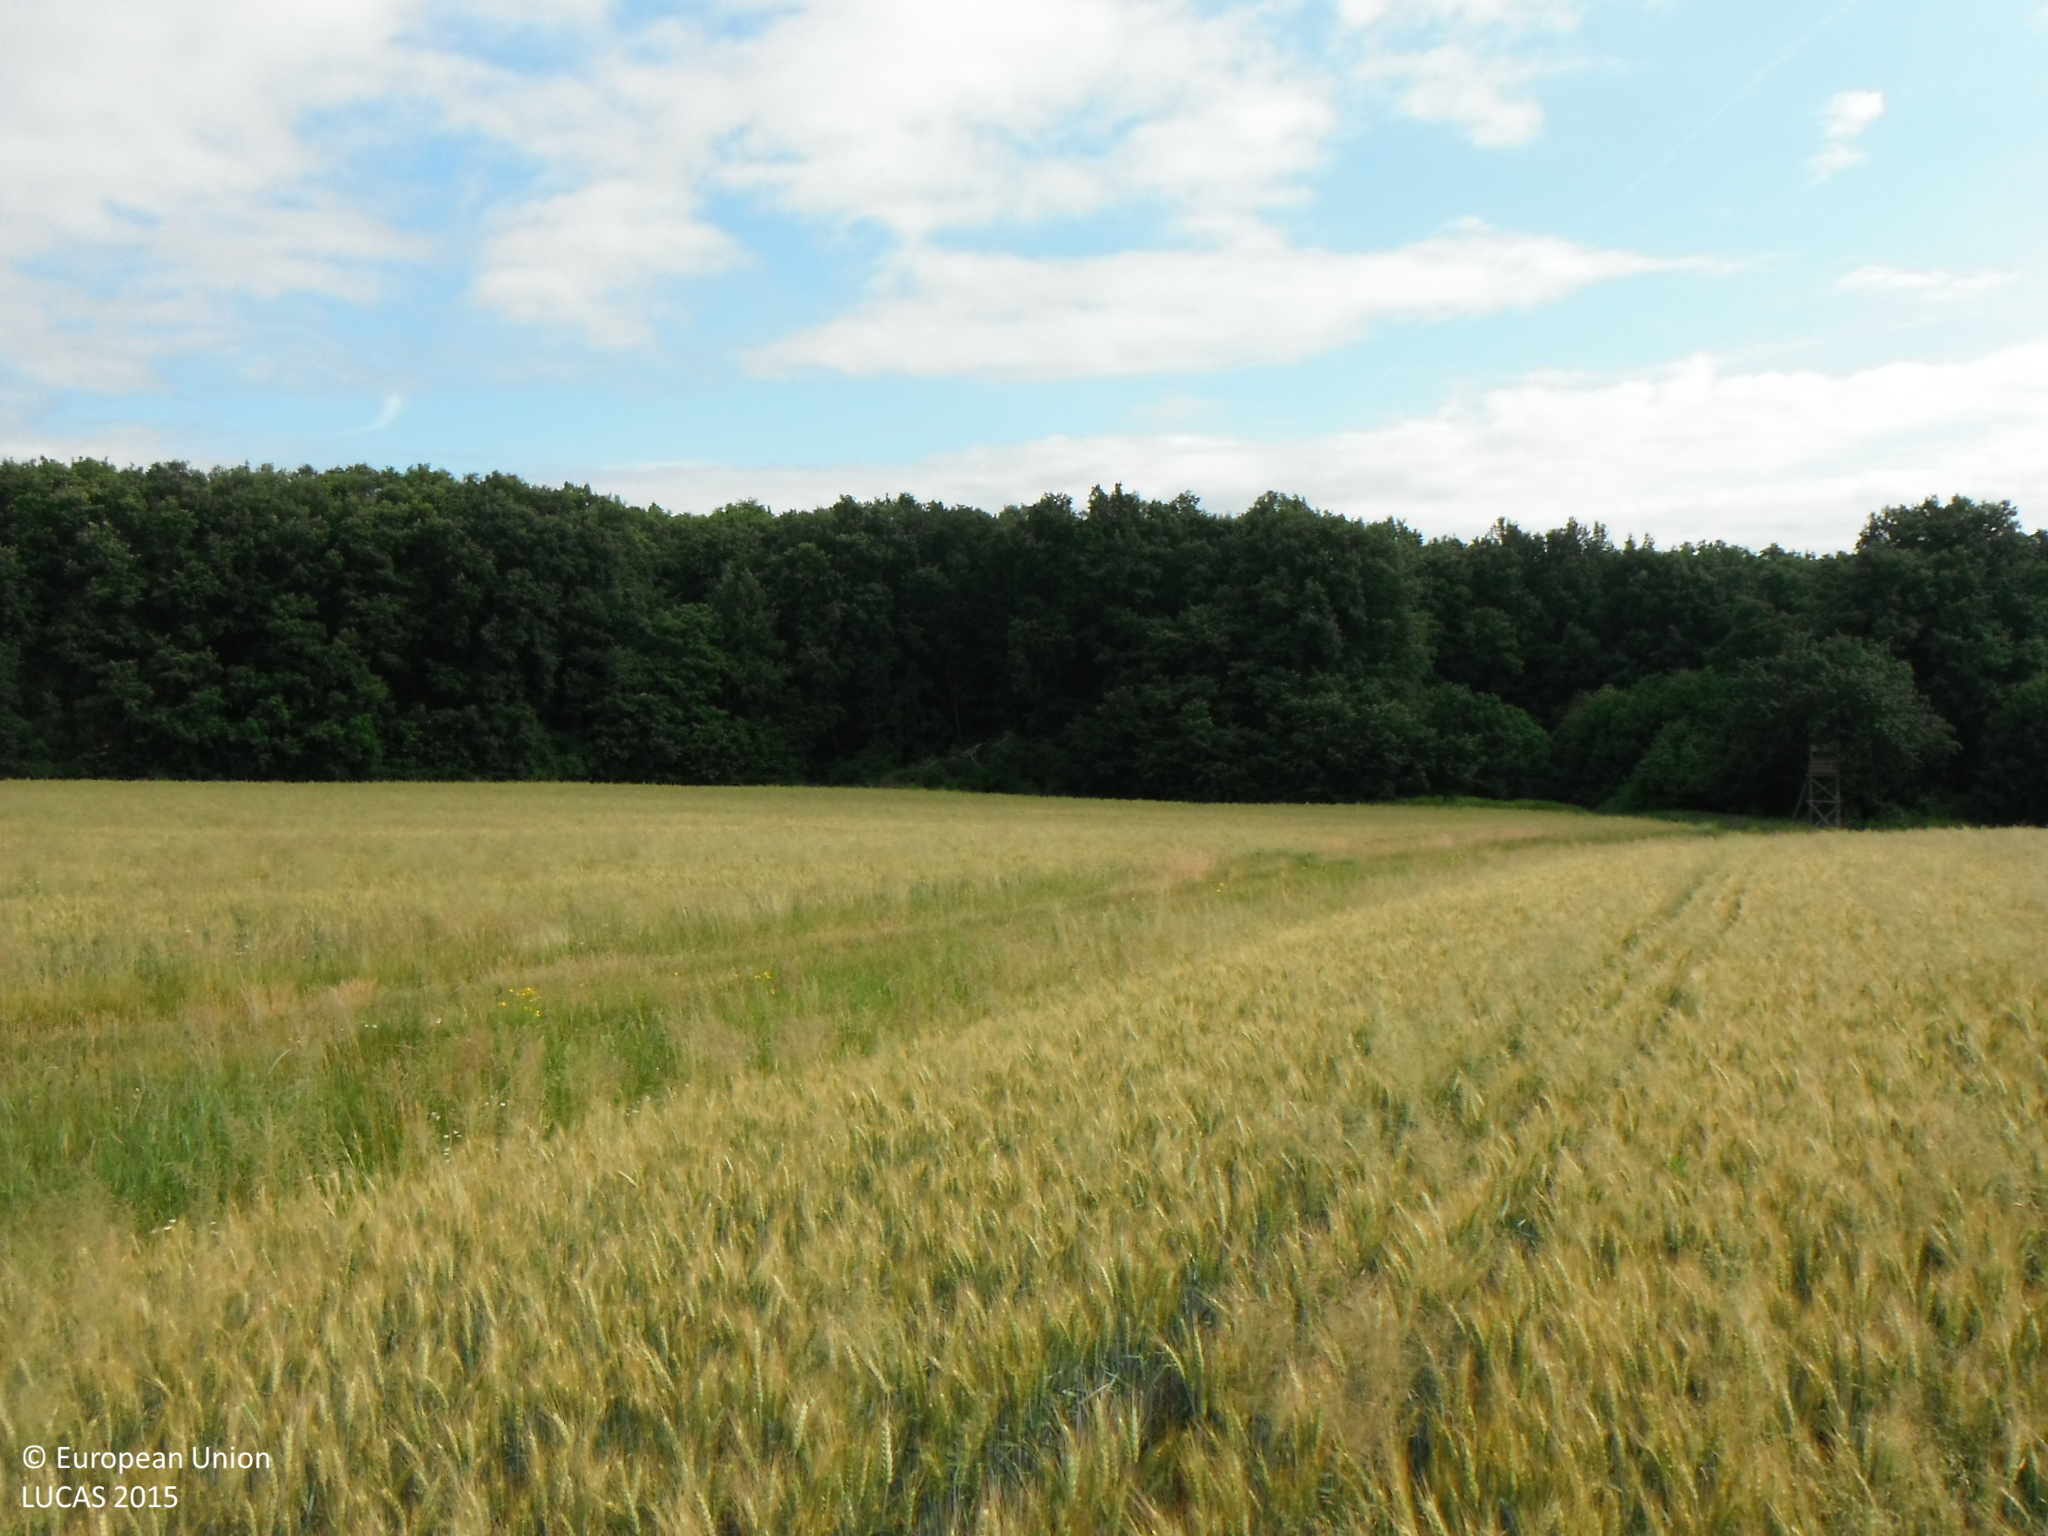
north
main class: Cropland
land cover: Common wheat
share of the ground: > 75 %
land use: Agriculture (excluding fallow land and kitchen gardens)
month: June
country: SK
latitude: 48.2526
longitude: 19.4380
